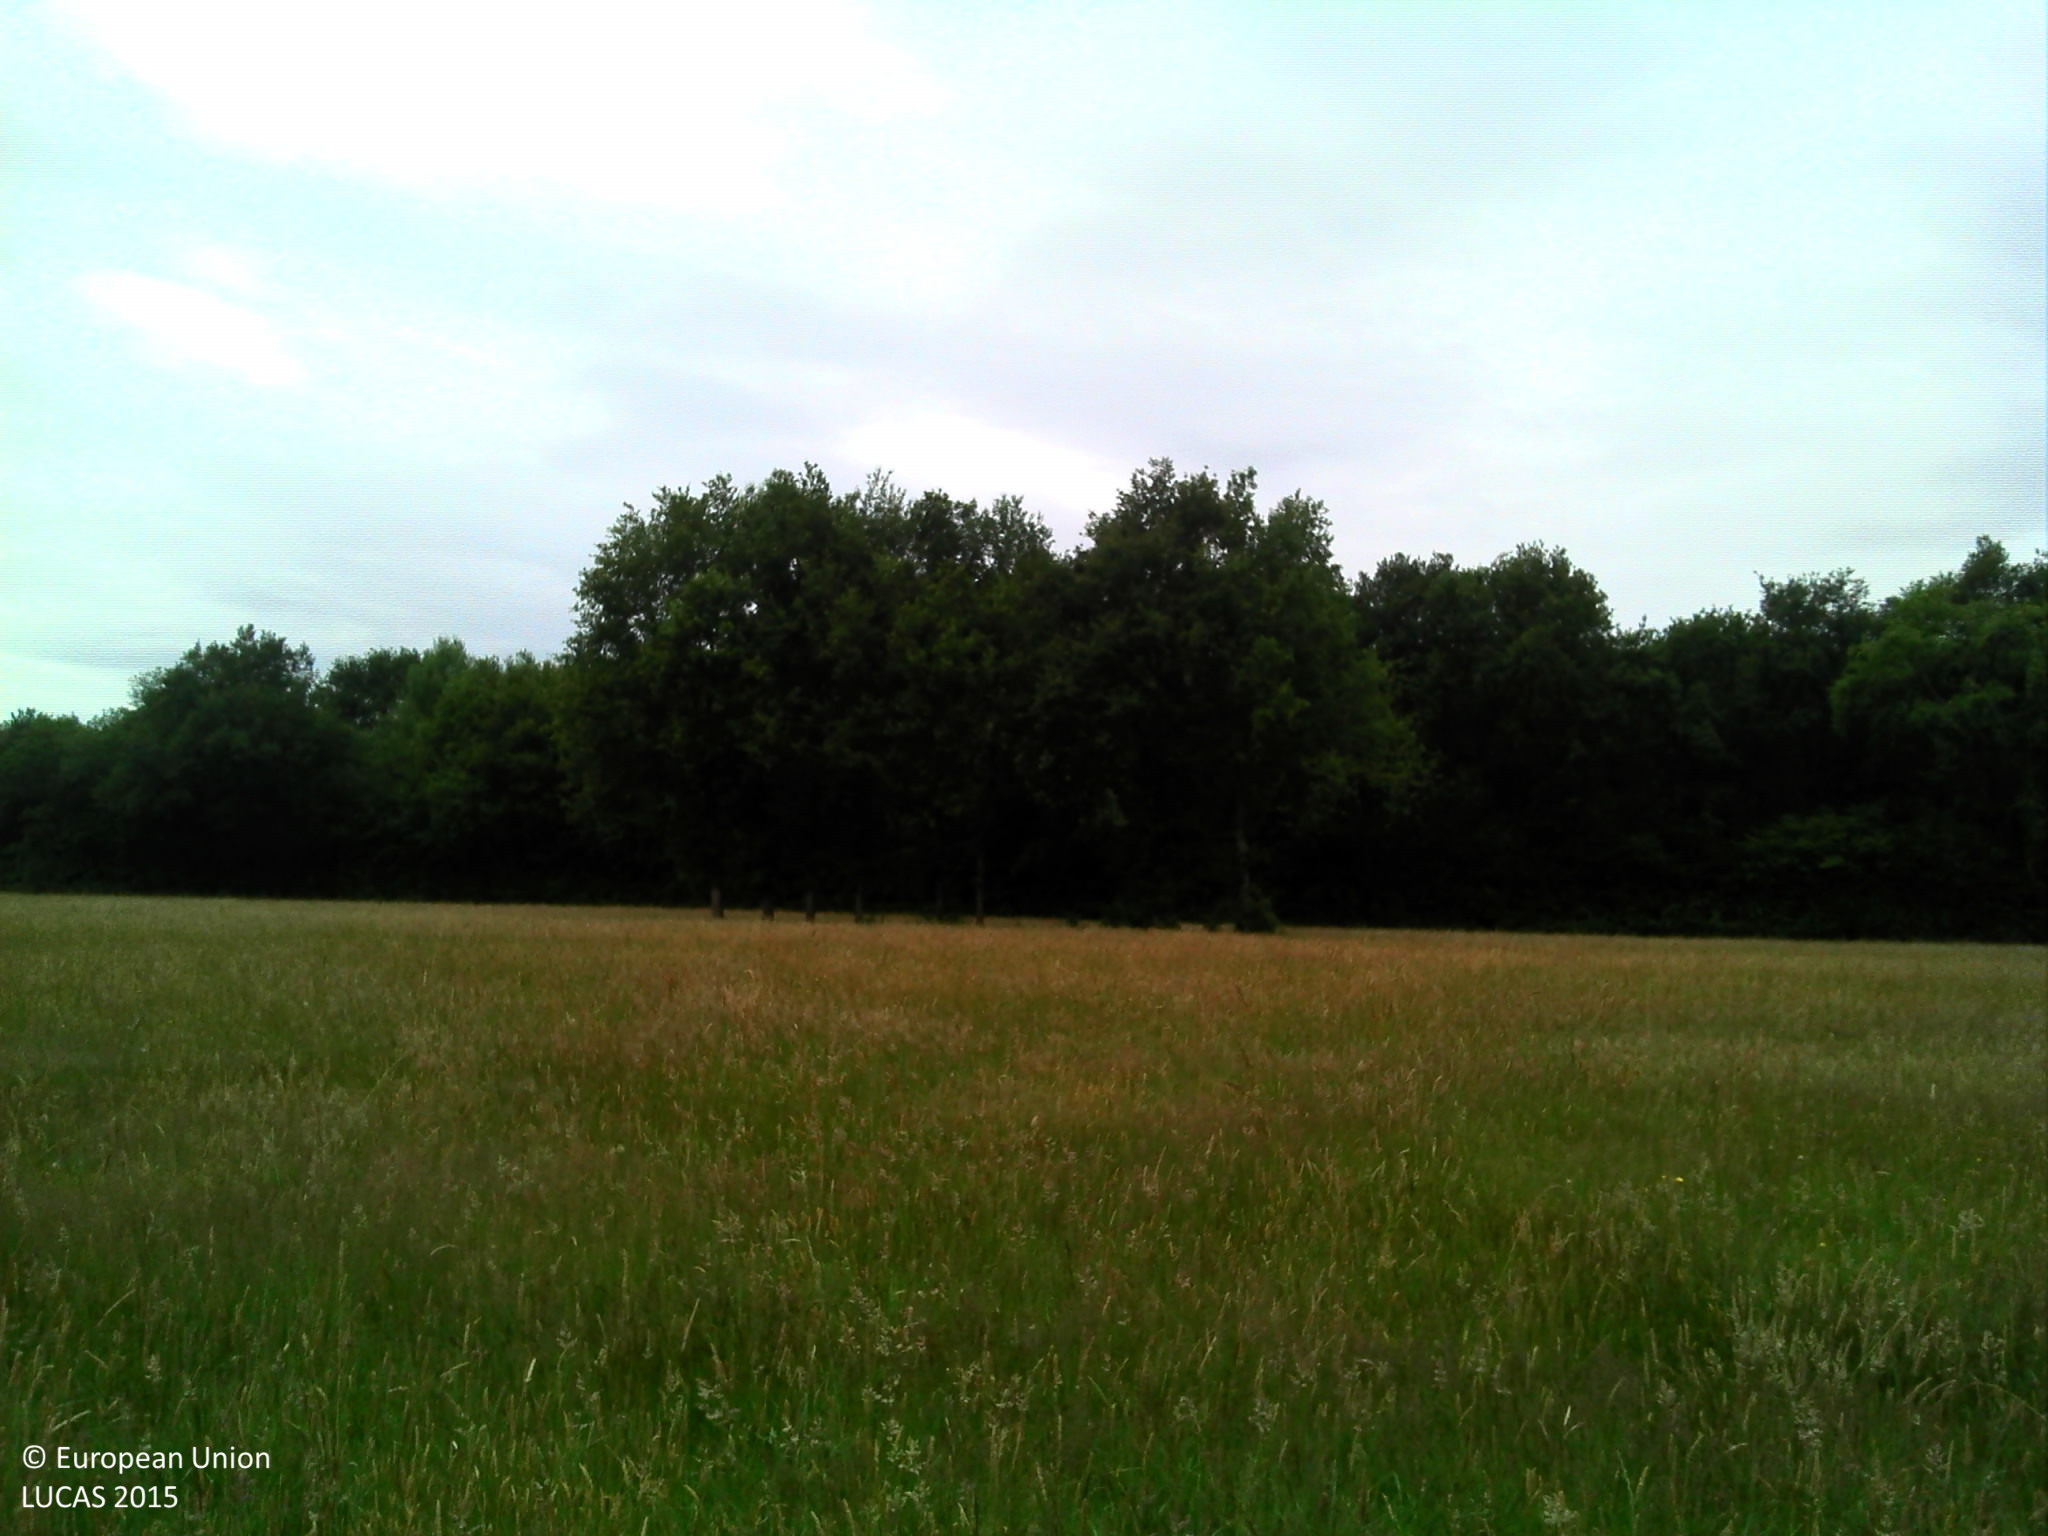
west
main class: Grassland
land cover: Grassland without tree/shrub cover
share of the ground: > 75 %
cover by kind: herbaceous plants 100 %
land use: Agriculture (excluding fallow land and kitchen gardens)
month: June
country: FR
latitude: 47.6460
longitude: 0.0565
